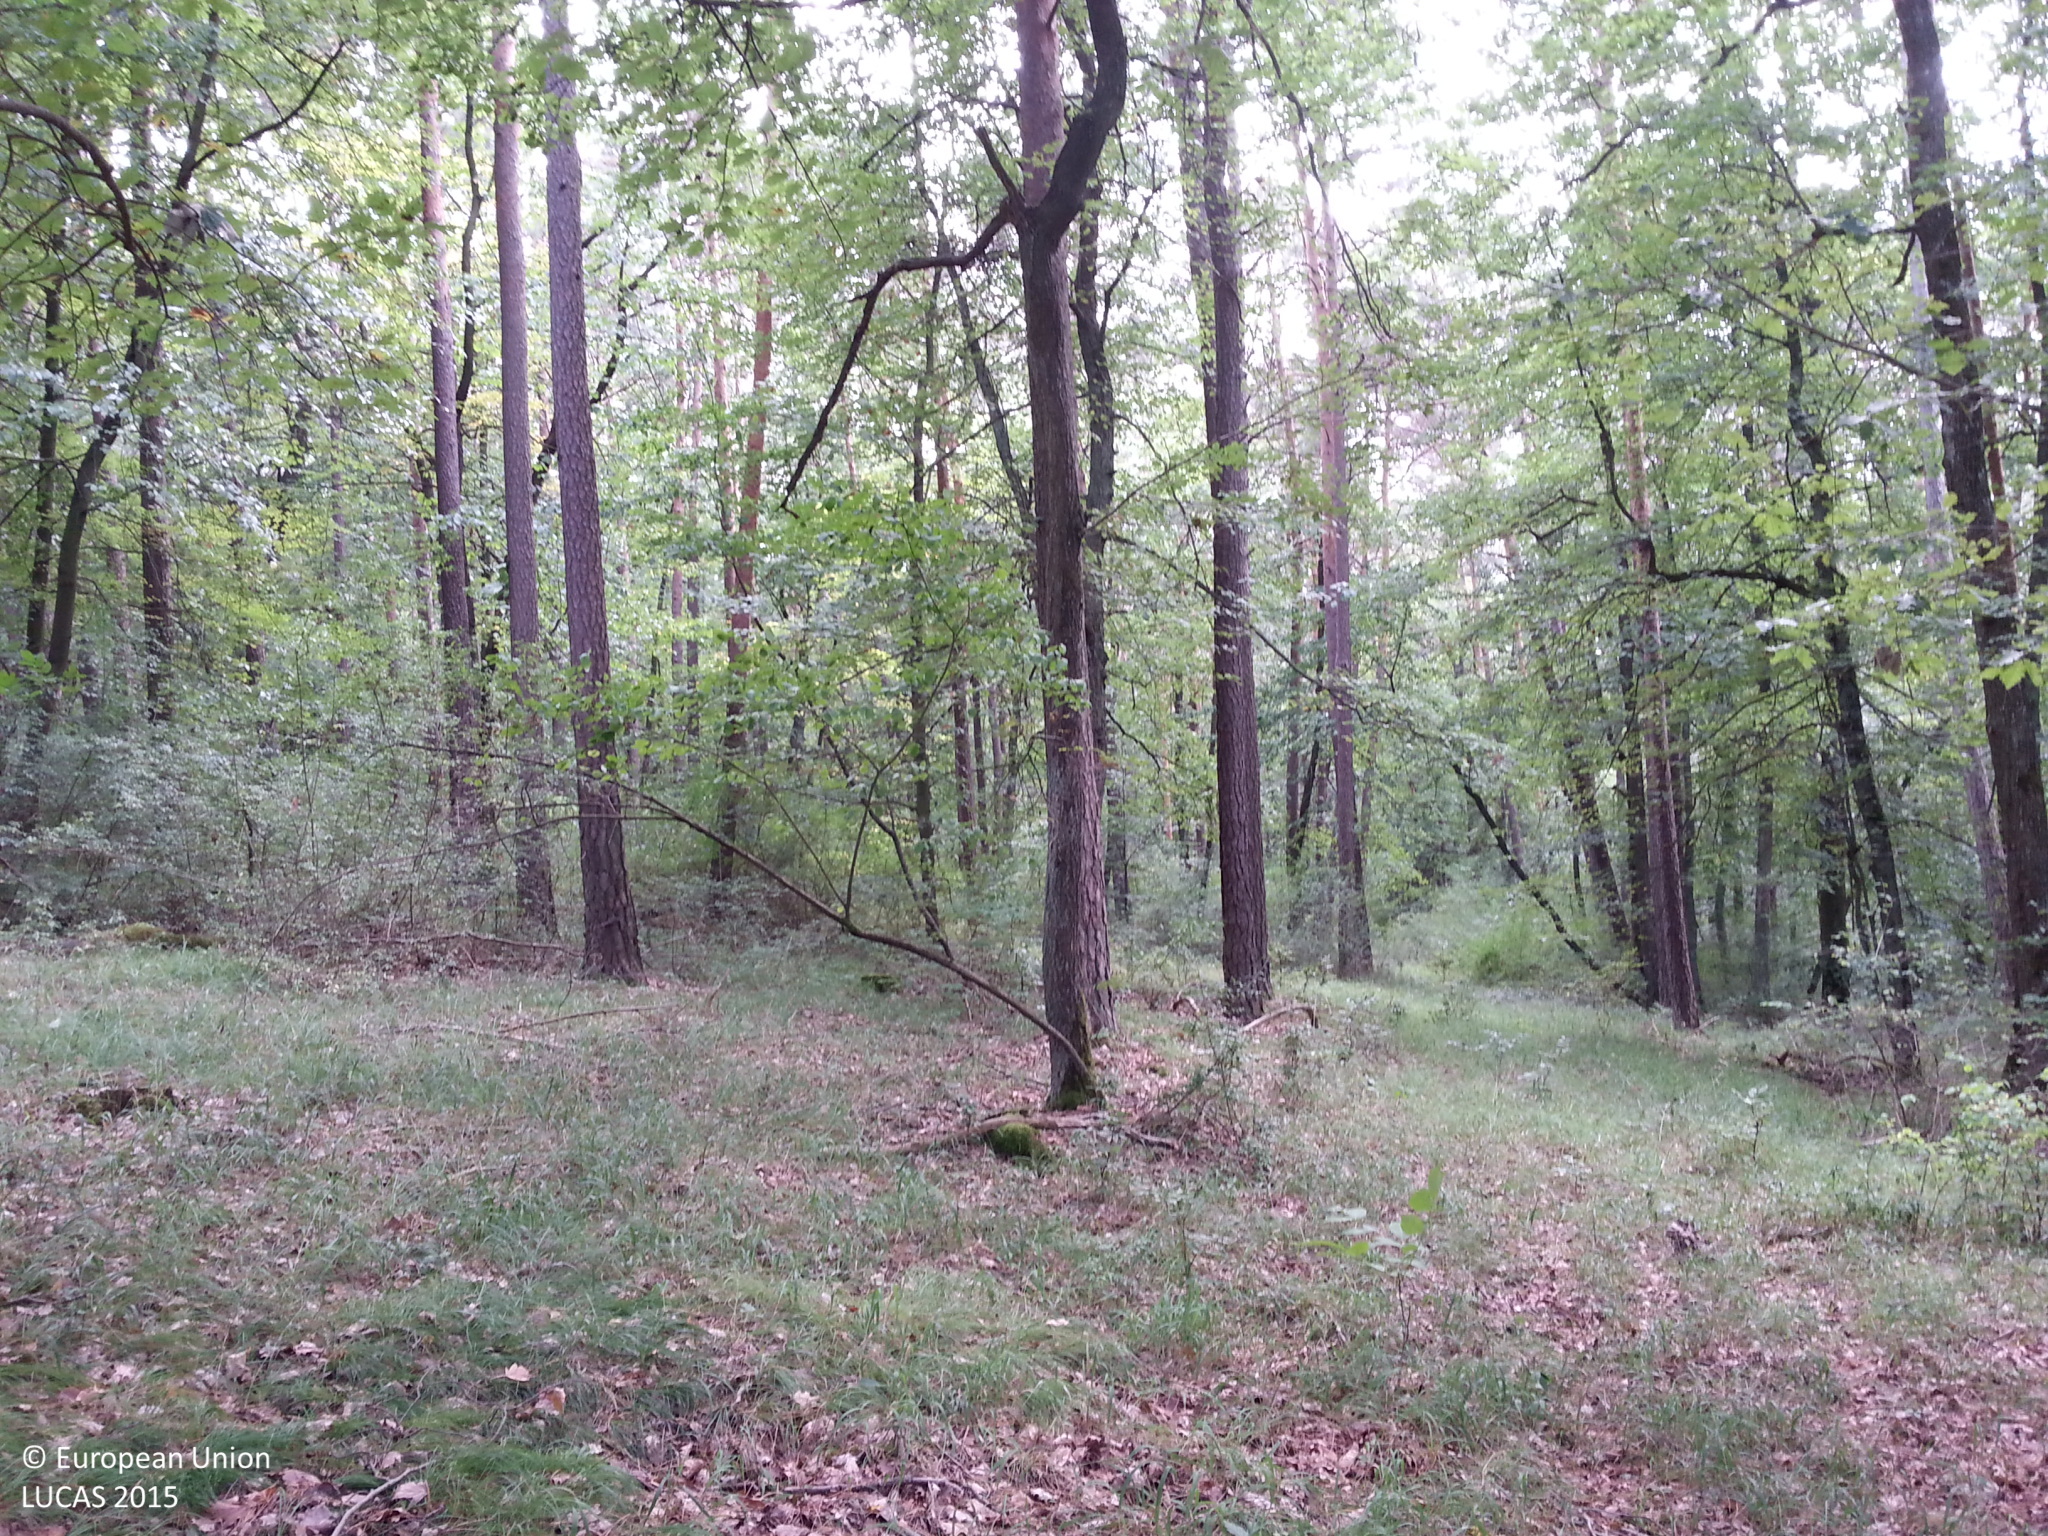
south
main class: Woodland
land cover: Pine dominated mixed woodland
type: hemiboreal forest and nemoral coniferous forest and mixed broadleaved-coniferous forest
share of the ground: > 75 %
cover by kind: coniferous forest trees 55 %, broadleaved forest trees 35 %, herbaceous plants 5 %, unconsolidated bare surface 5 %
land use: Forestry
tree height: > 5 m
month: September
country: DE
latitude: 49.6619
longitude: 9.5707
